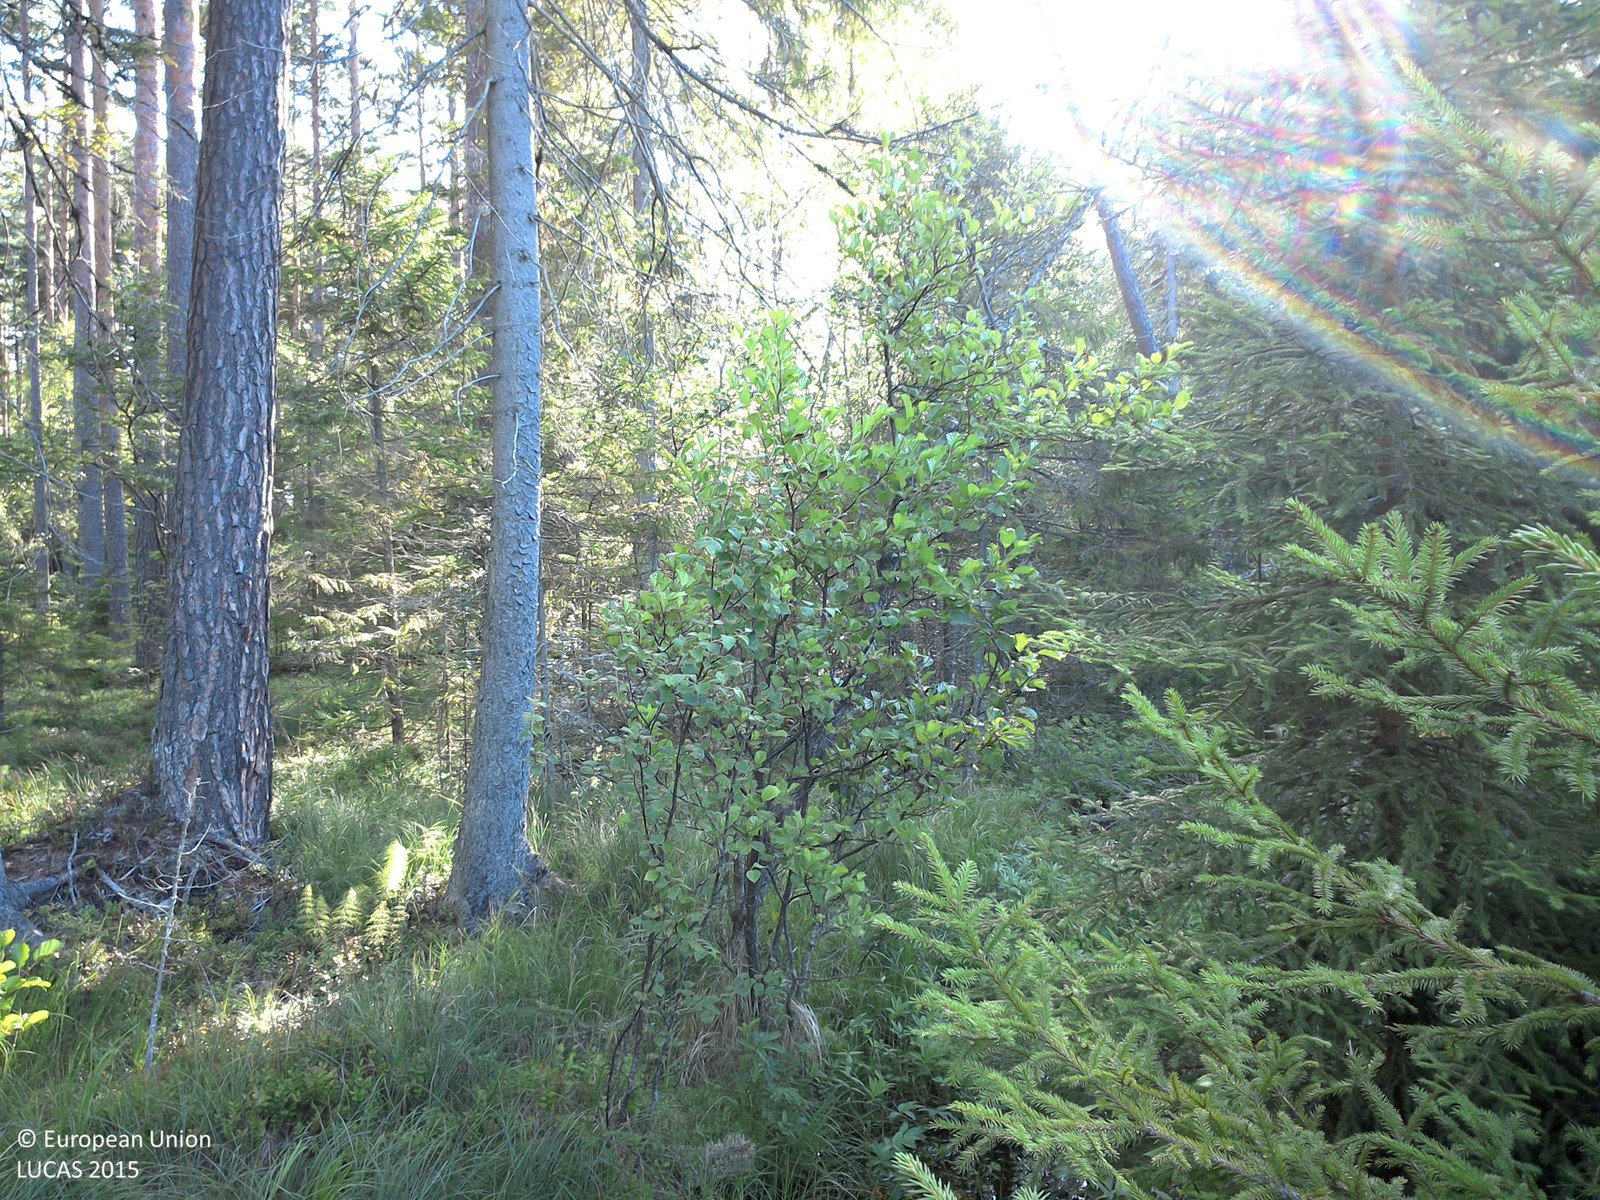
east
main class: Woodland
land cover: Pine dominated mixed woodland
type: boreal forest
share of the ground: 50 - 75 %
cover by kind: coniferous forest trees 50 %, herbaceous plants 30 %, broadleaved forest trees 20 %
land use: Forestry
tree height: > 5 m
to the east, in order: Pine dominated mixed woodland; Ditches and canals; Pine dominated coniferous woodland; Spruce dominated coniferous woodland
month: August
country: SE
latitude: 58.1097
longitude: 14.9672
